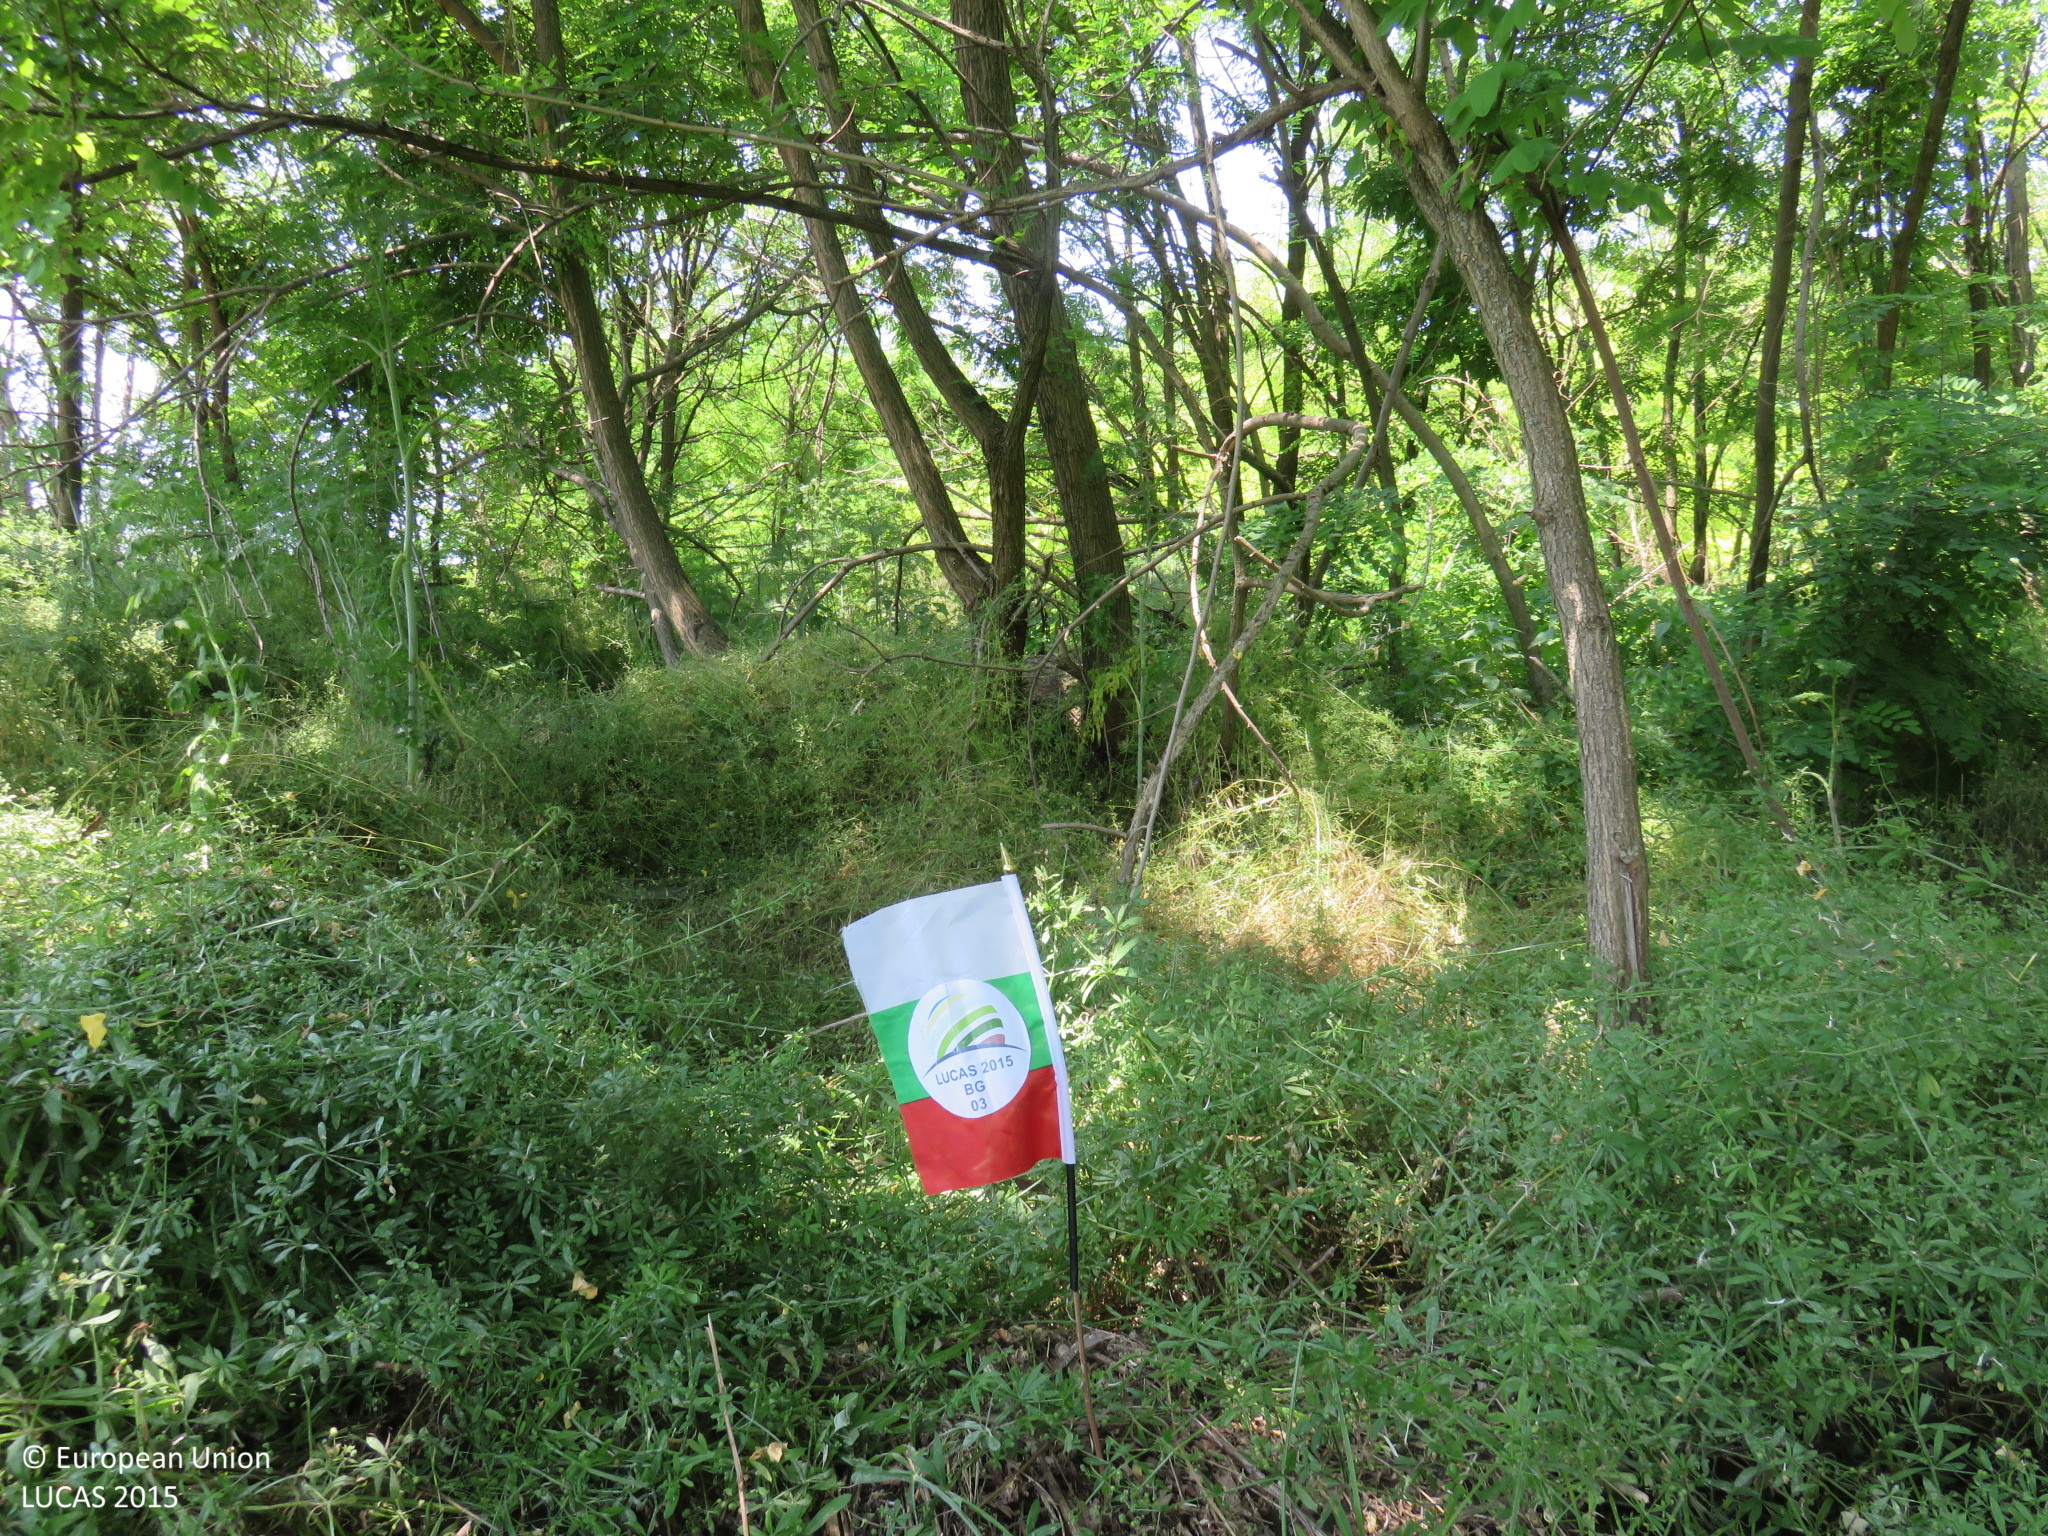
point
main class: Woodland
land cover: Broadleaved woodland
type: exotic forest
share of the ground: > 75 %
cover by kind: broadleaved forest trees 80 %, shrubs 10 %, herbaceous plants 10 %
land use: Forestry
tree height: < 5 m
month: June
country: BG
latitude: 43.3398
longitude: 24.5294
